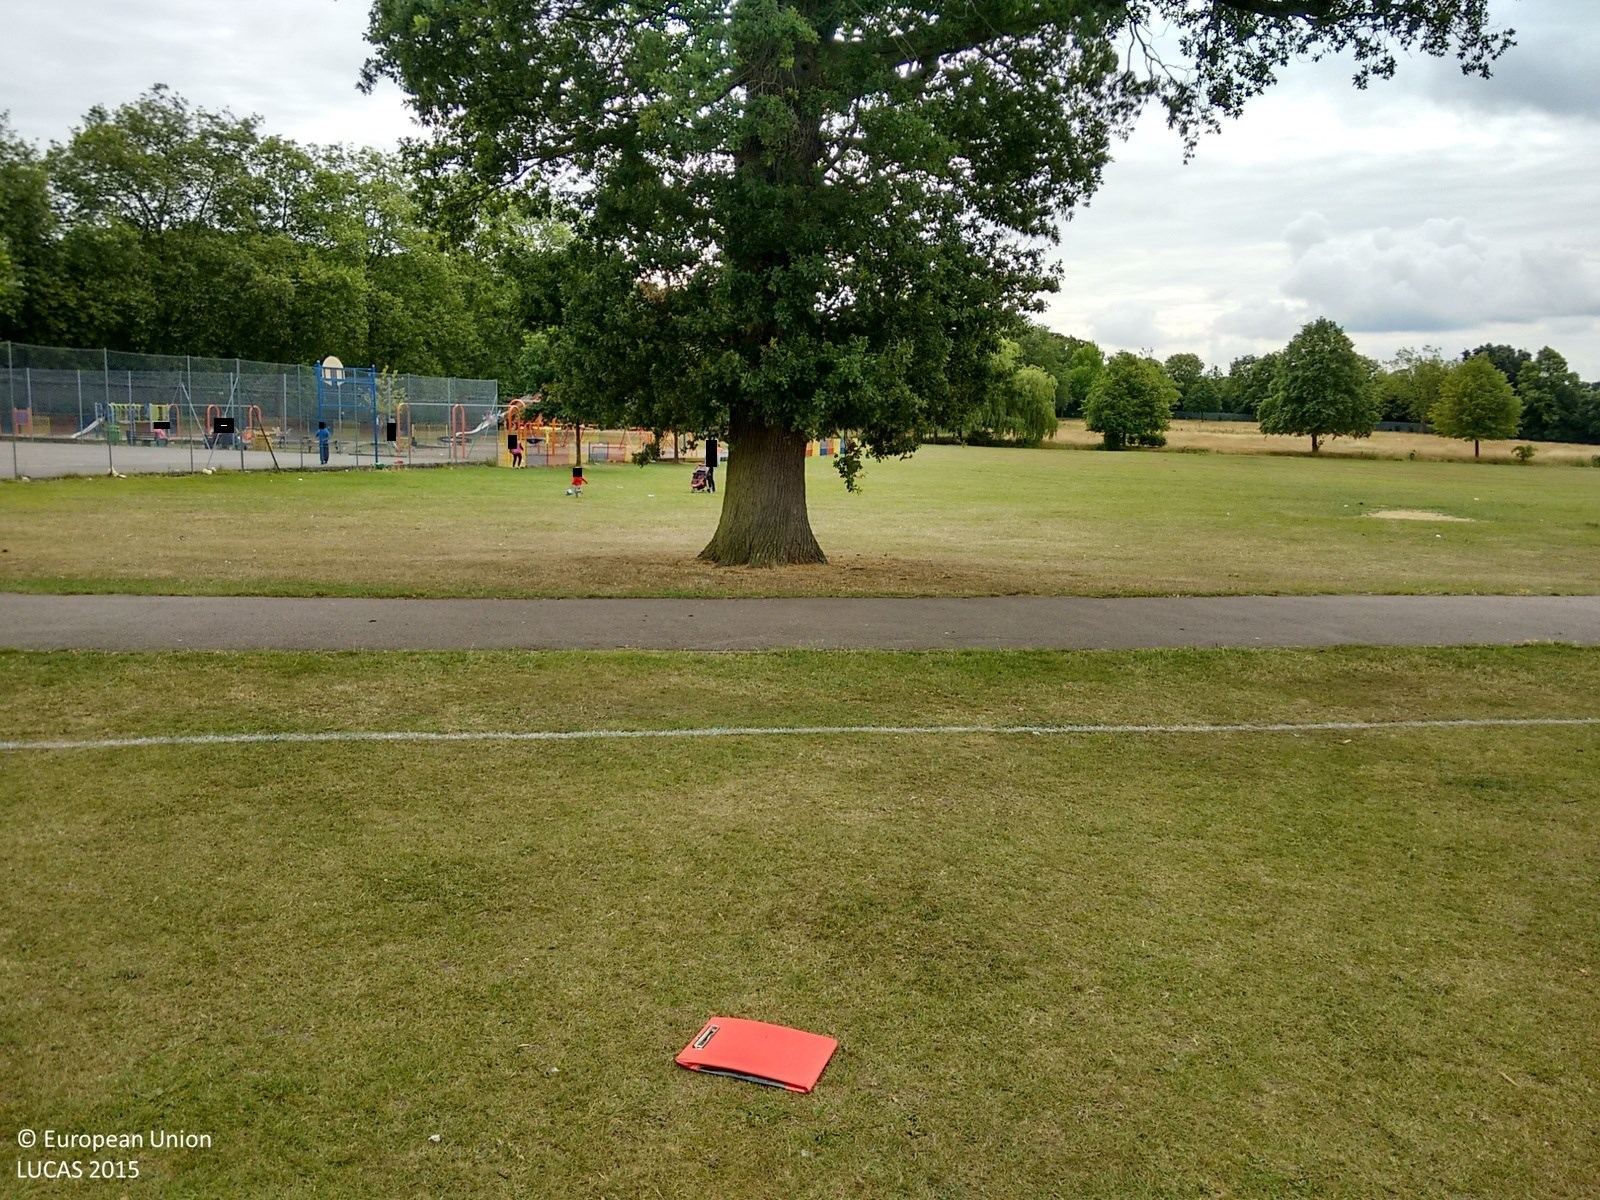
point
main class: Grassland
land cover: Grassland without tree/shrub cover
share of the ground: > 75 %
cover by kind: herbaceous plants 100 %
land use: Amenities, museums, leisure
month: July
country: GB
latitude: 51.5612
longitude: -0.3505
